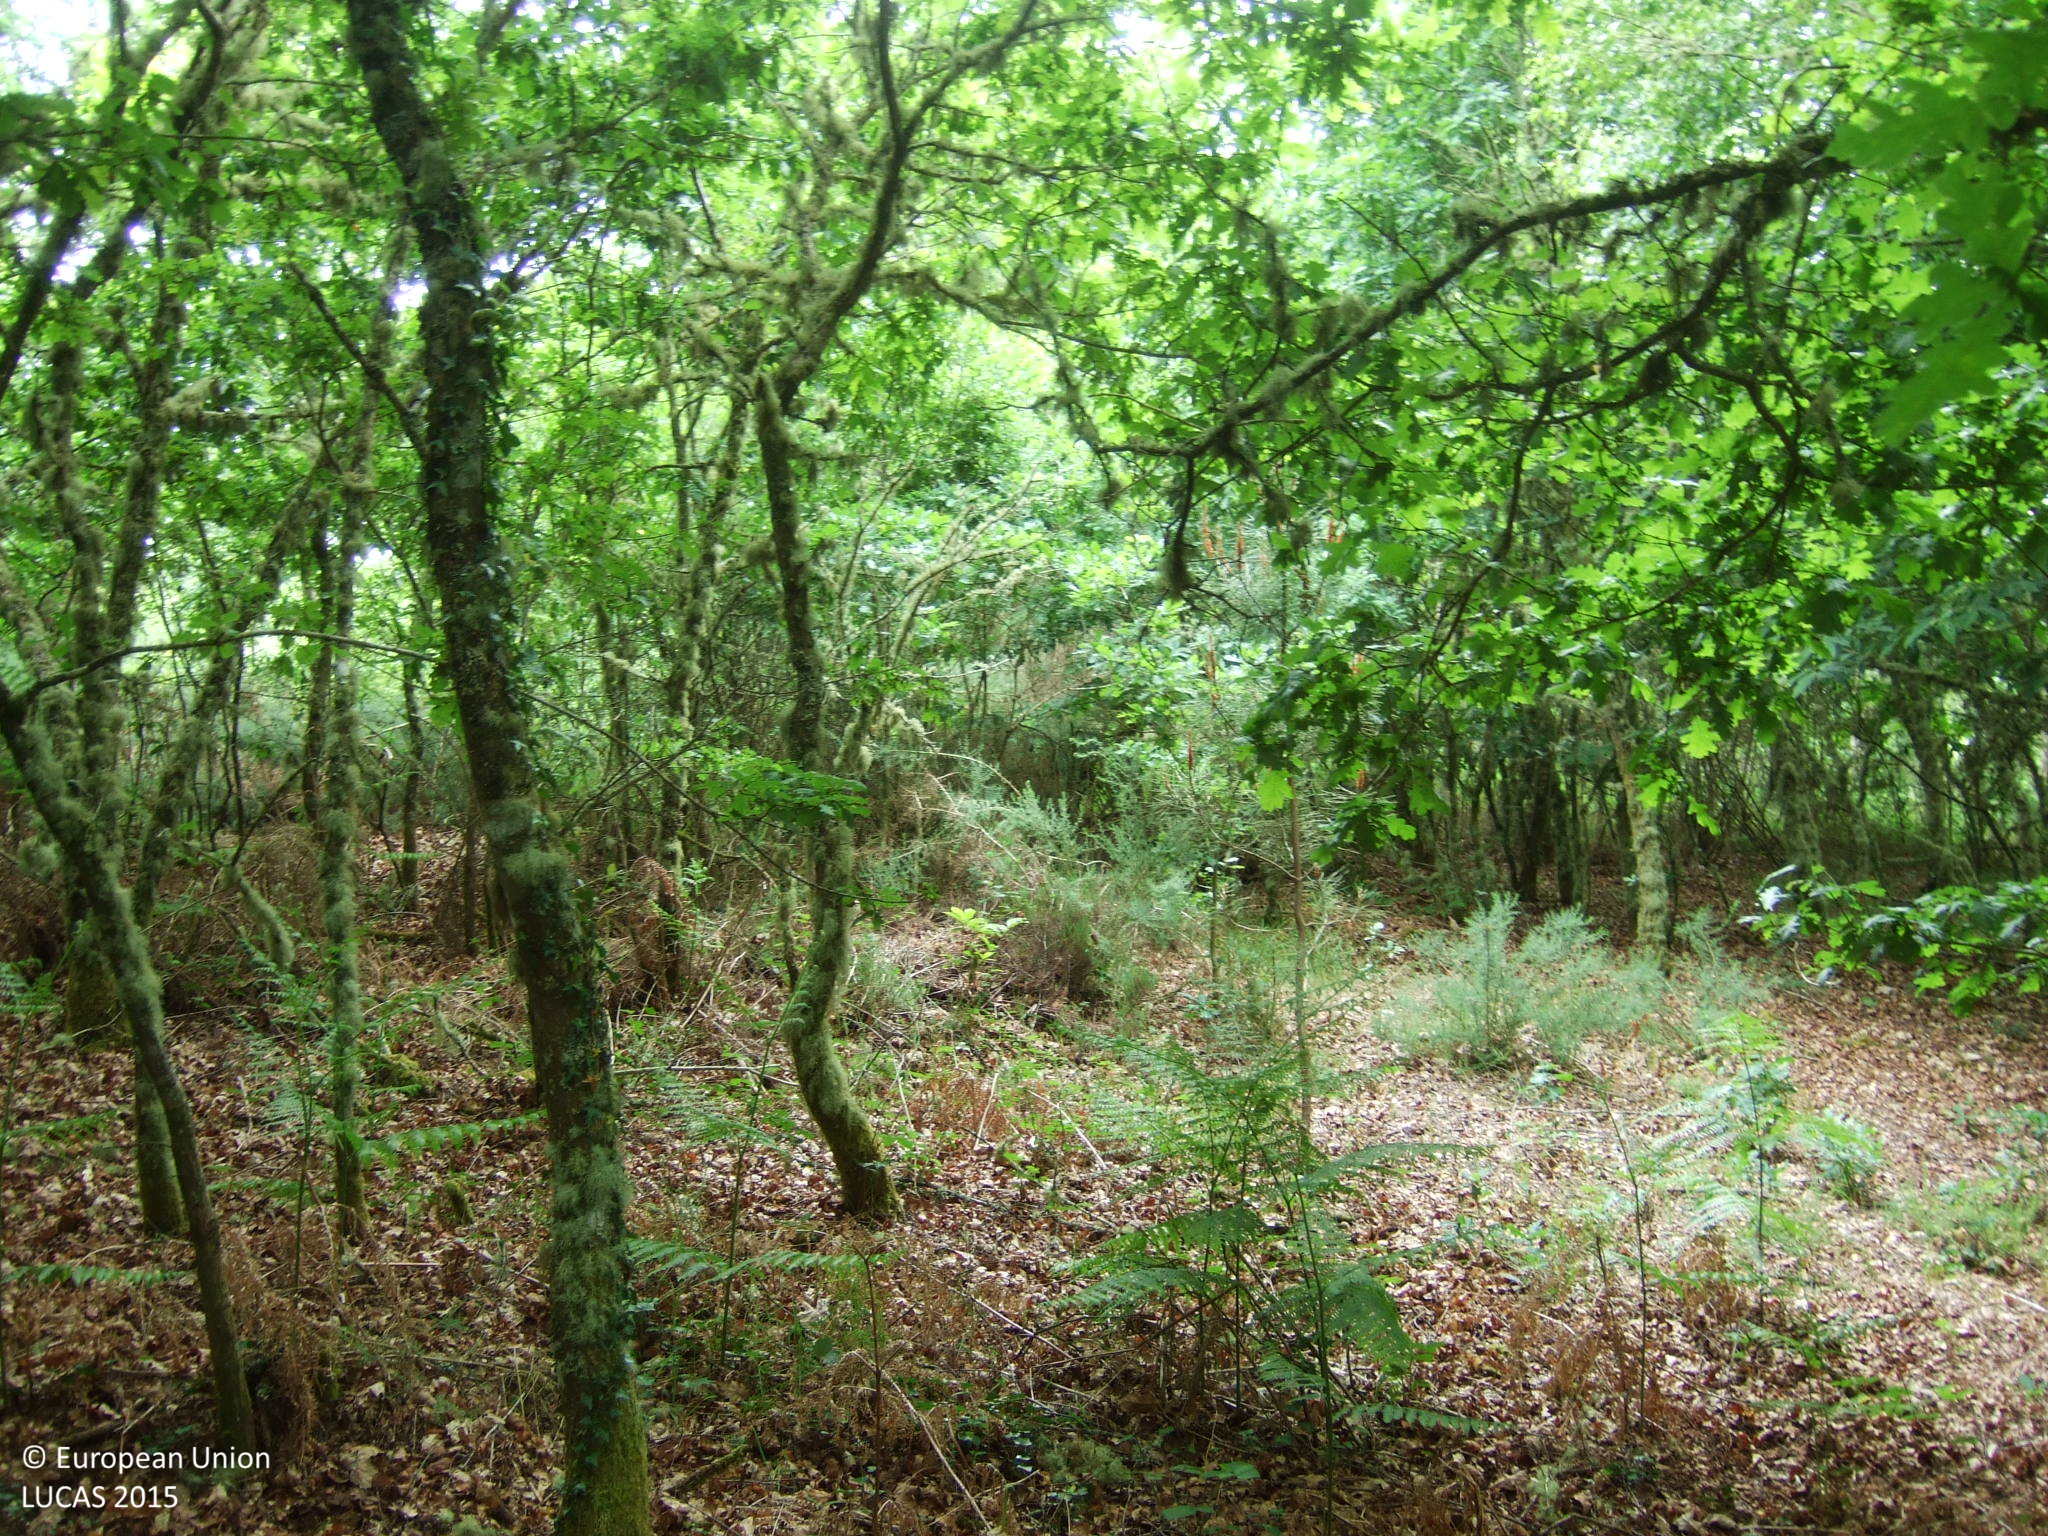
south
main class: Woodland
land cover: Broadleaved woodland
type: acidophilous oak and oak-birch forest
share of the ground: 50 - 75 %
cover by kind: broadleaved forest trees 70 %, shrubs 15 %, herbaceous plants 15 %
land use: Forestry
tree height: > 5 m
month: June
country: ES
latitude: 43.3726
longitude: -7.7733
